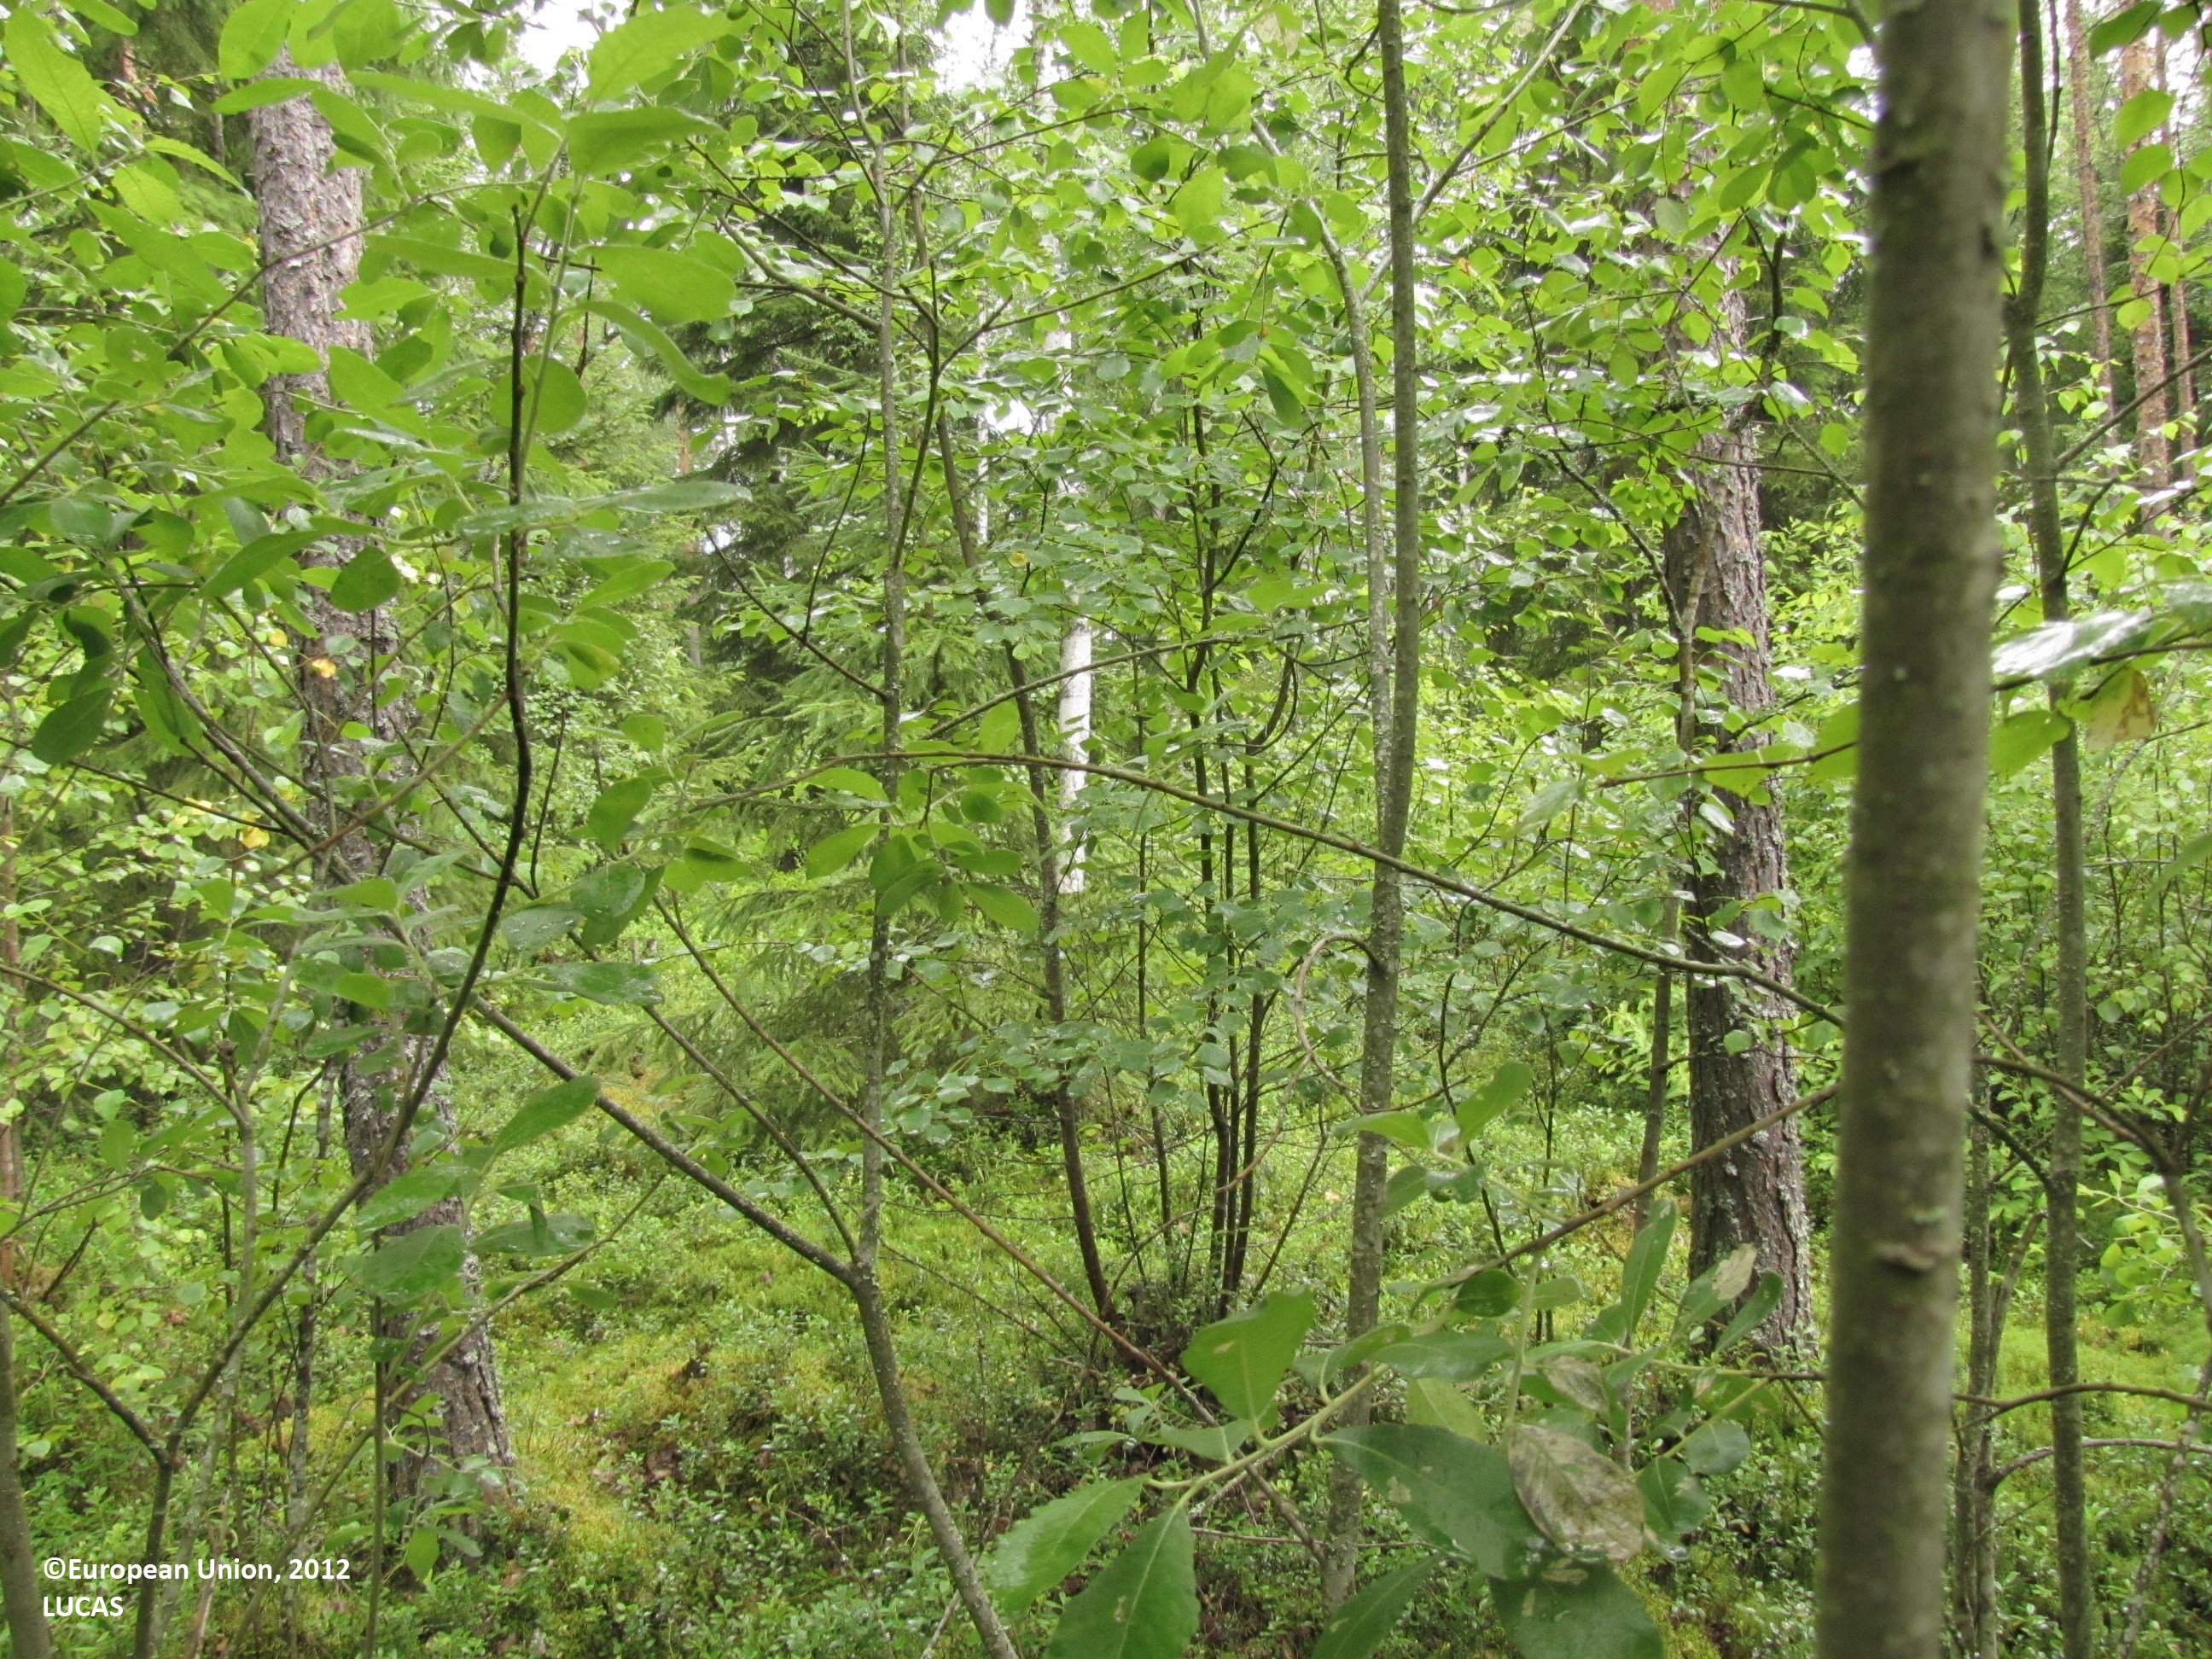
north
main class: Woodland
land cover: Other mixed woodland
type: boreal forest
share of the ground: > 75 %
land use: Forestry
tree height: > 5 m
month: July
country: FI
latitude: 62.5977
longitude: 22.9746
